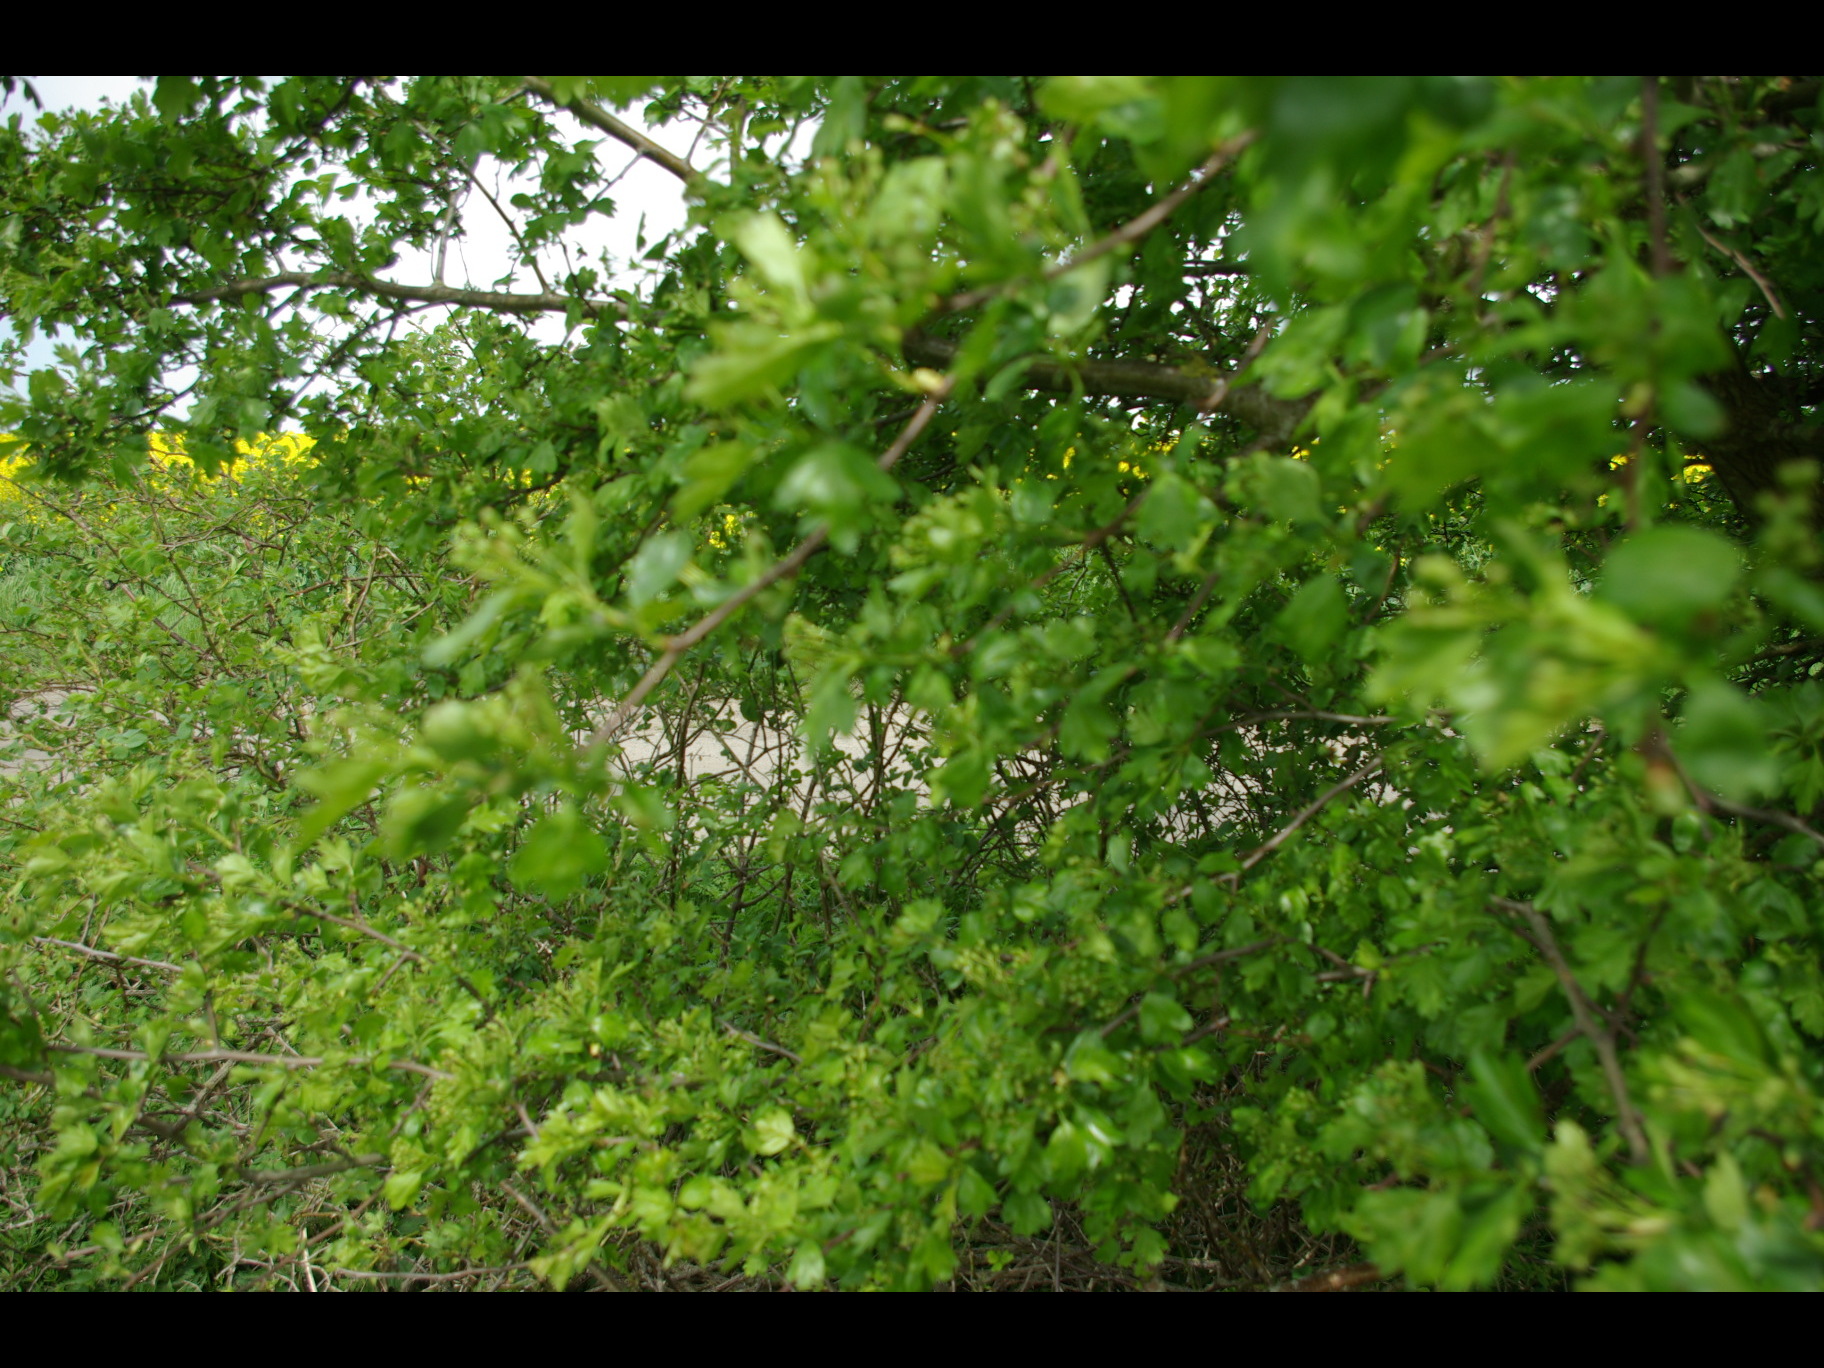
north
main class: Cropland
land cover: Rape and turnip rape
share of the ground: > 75 %
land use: Agriculture (excluding fallow land and kitchen gardens)
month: May
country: DE
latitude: 54.4928
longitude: 11.1572
